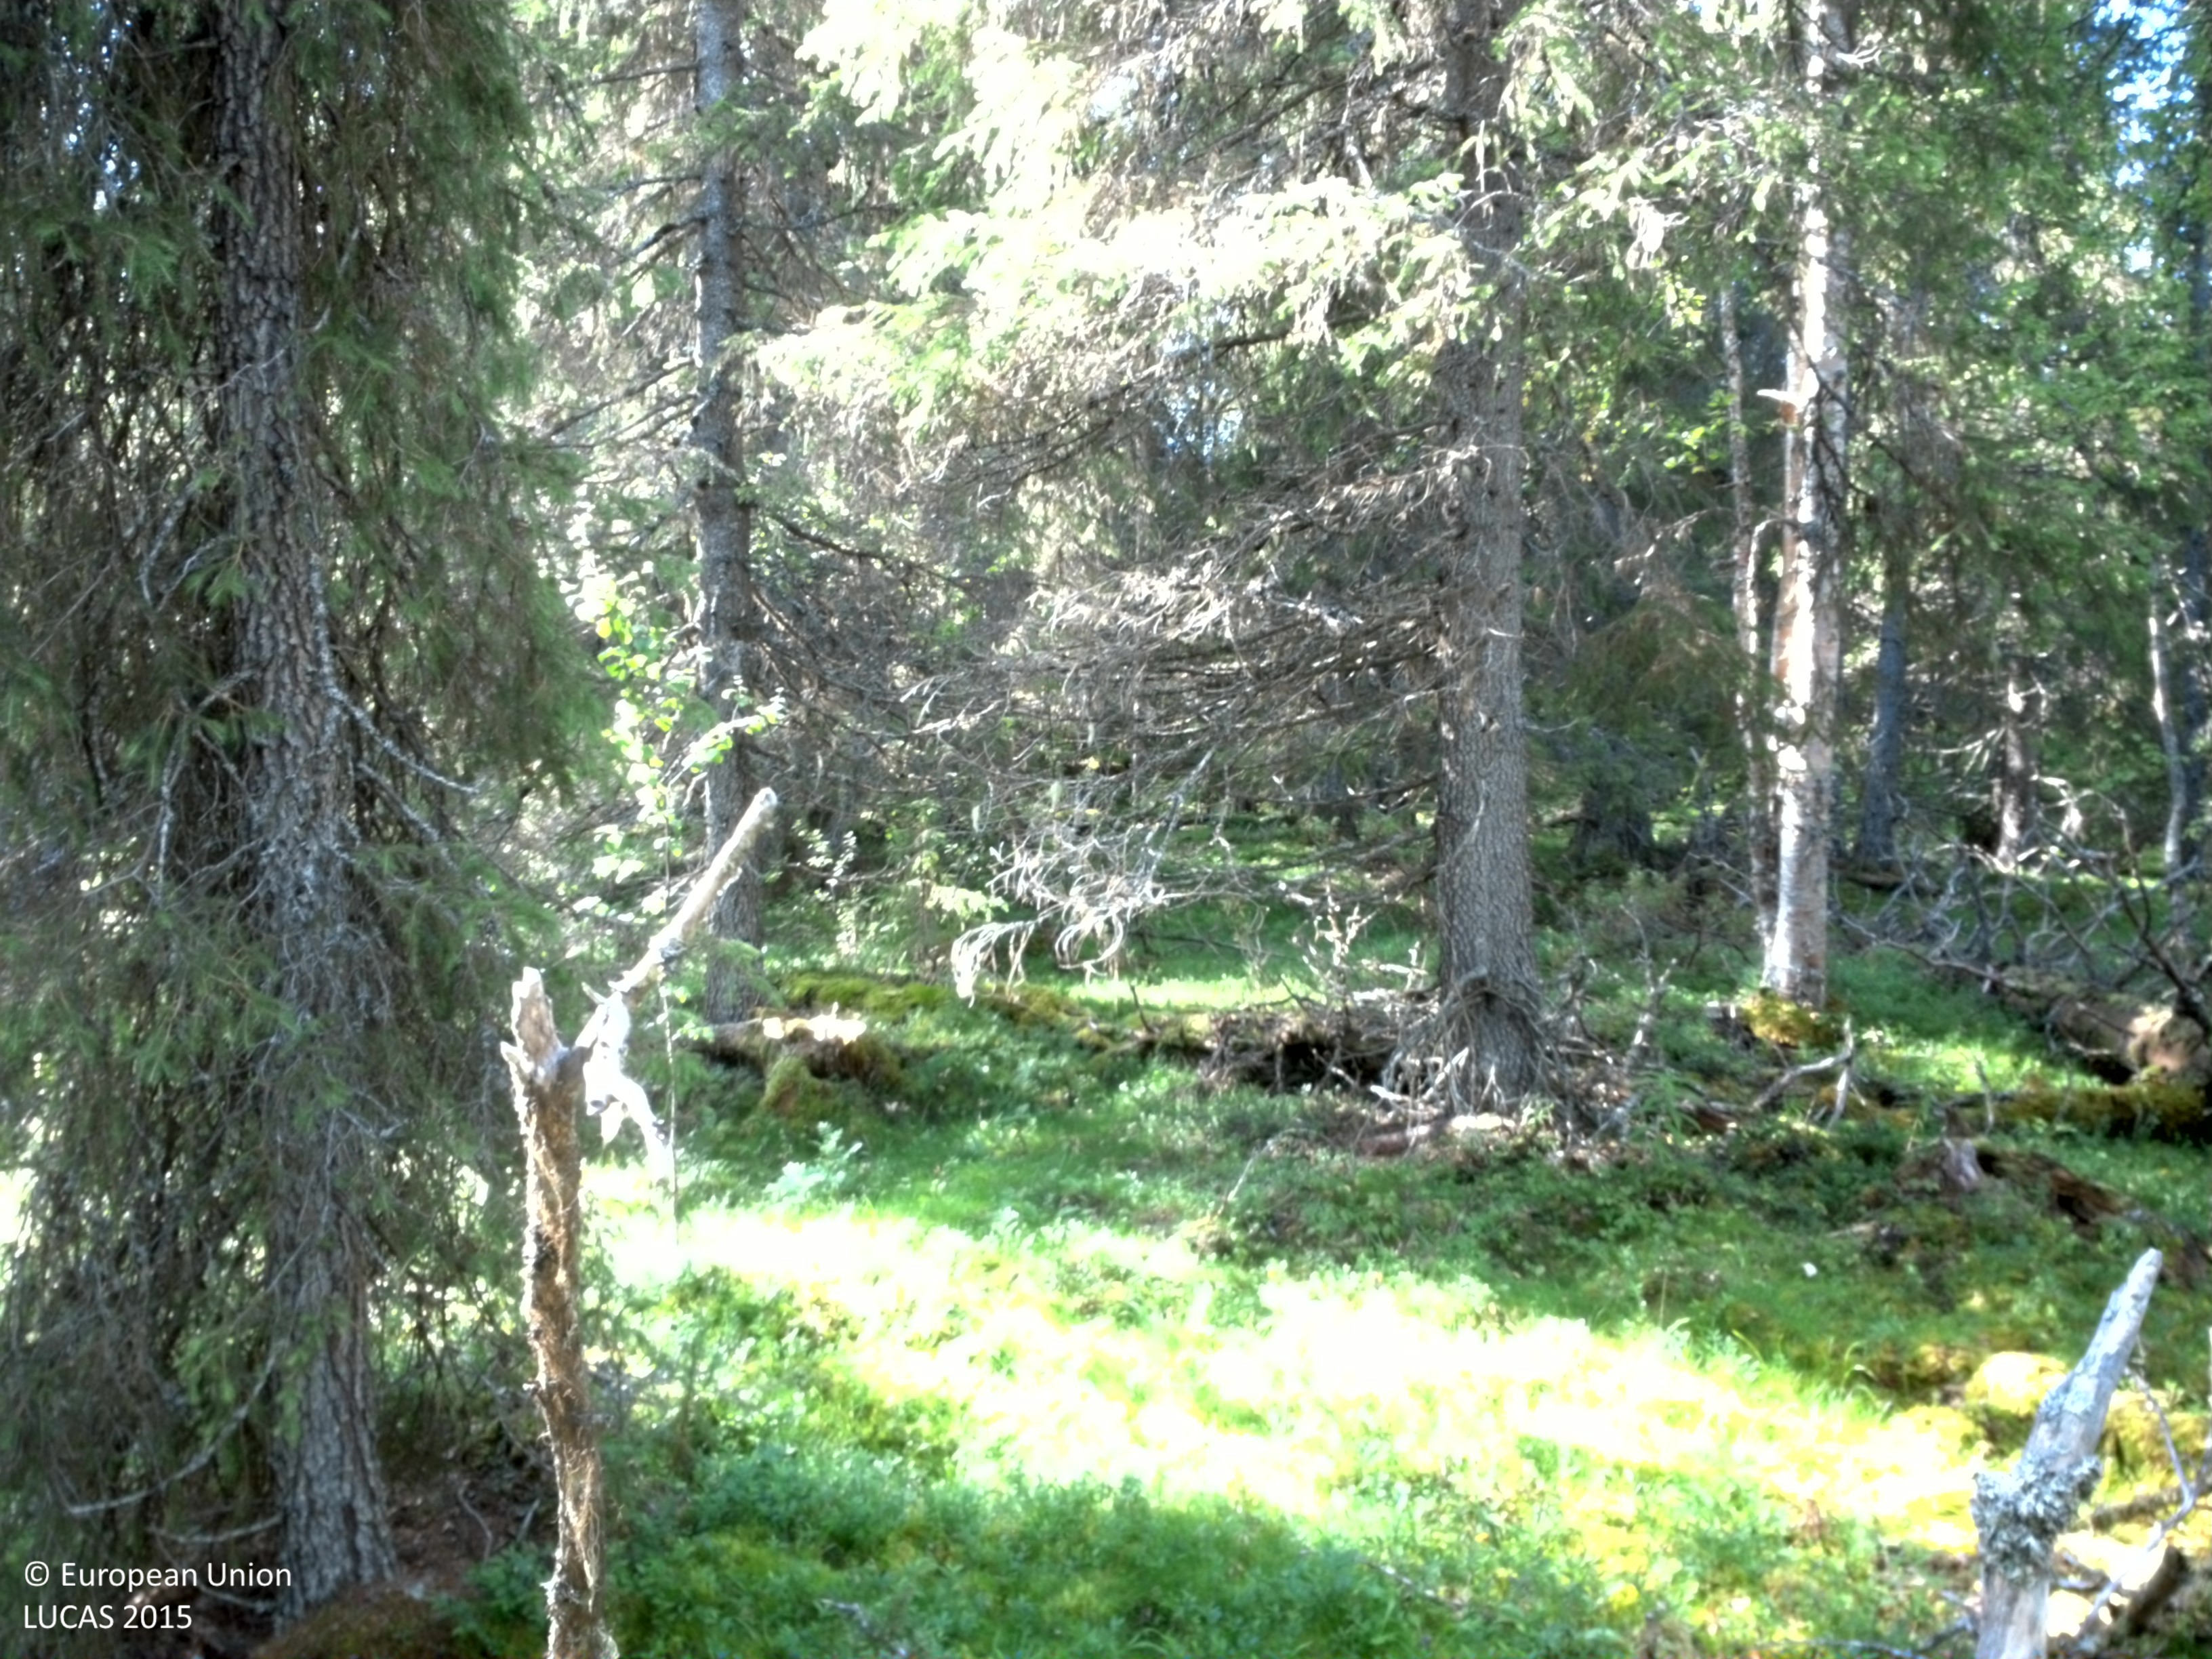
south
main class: Woodland
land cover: Spruce dominated coniferous woodland
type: boreal forest
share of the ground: 25 - 50 %
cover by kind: coniferous forest trees 30 %, shrubs 25 %, herbaceous plants 25 %, lichens and mosses 15 %, broadleaved forest trees 5 %
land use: Amenities, museums, leisure
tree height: > 5 m
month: August
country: SE
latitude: 64.9845
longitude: 16.6408
